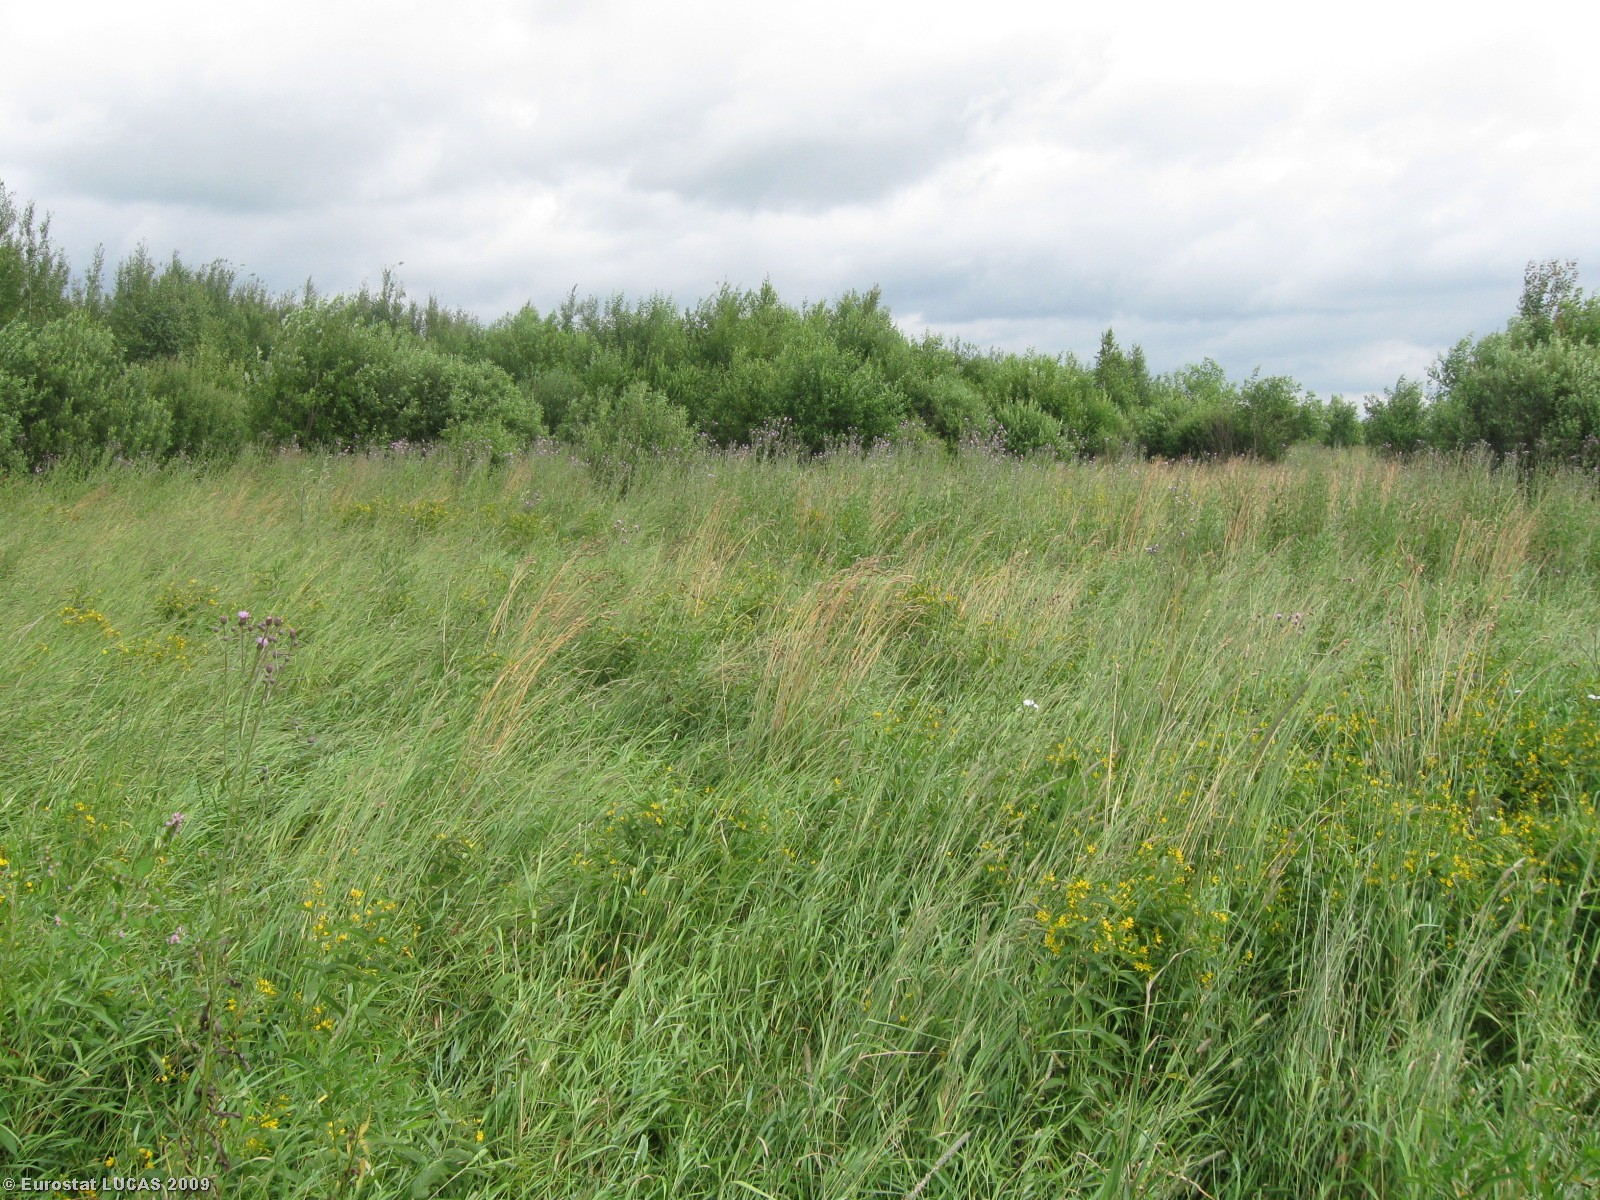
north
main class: Grassland
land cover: Spontaneously vegetated surfaces
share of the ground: > 75 %
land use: Fallow land
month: July
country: LT
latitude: 54.4307
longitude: 25.4965
